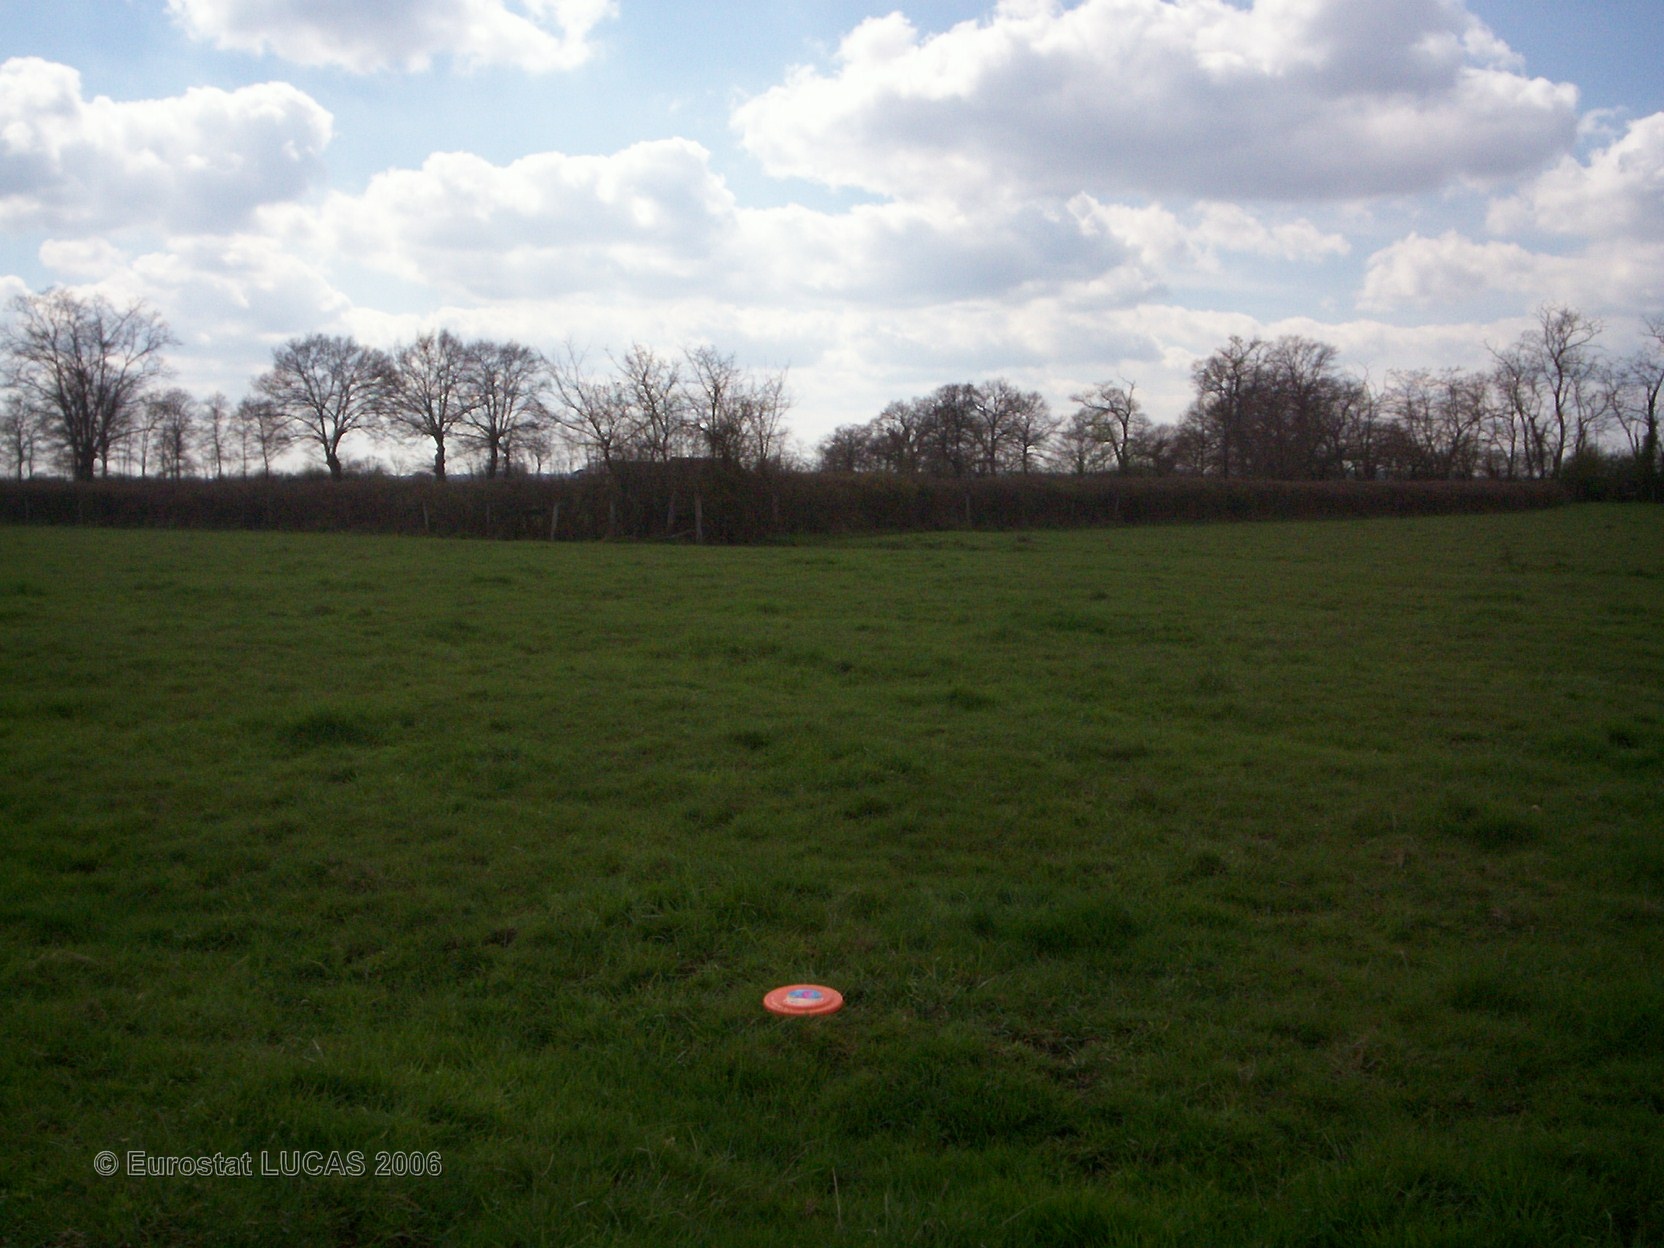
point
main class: Grassland
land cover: Grassland without tree/shrub cover
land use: Agriculture (excluding fallow land and kitchen gardens)
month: April
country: FR
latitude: 46.7948
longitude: 3.0660
